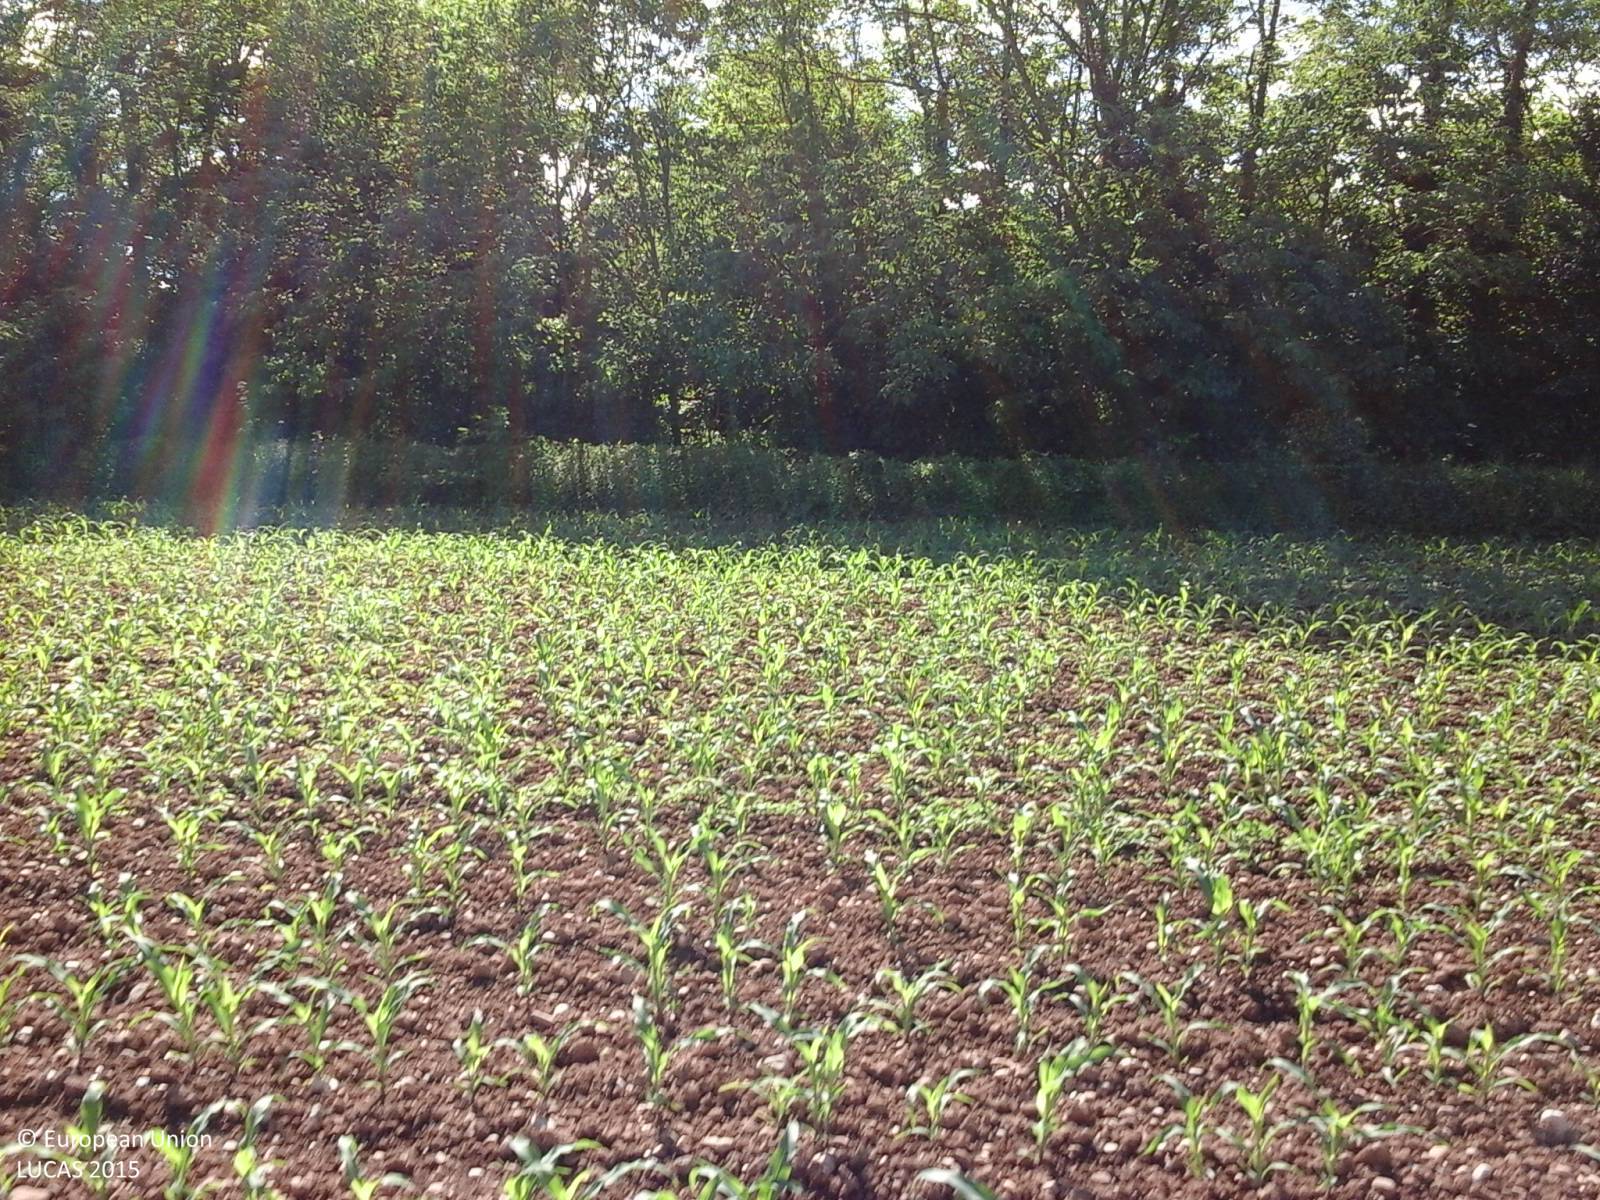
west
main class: Cropland
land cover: Maize
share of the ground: 10 - 25 %
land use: Agriculture (excluding fallow land and kitchen gardens)
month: May
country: IT
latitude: 45.9786
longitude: 13.2103
